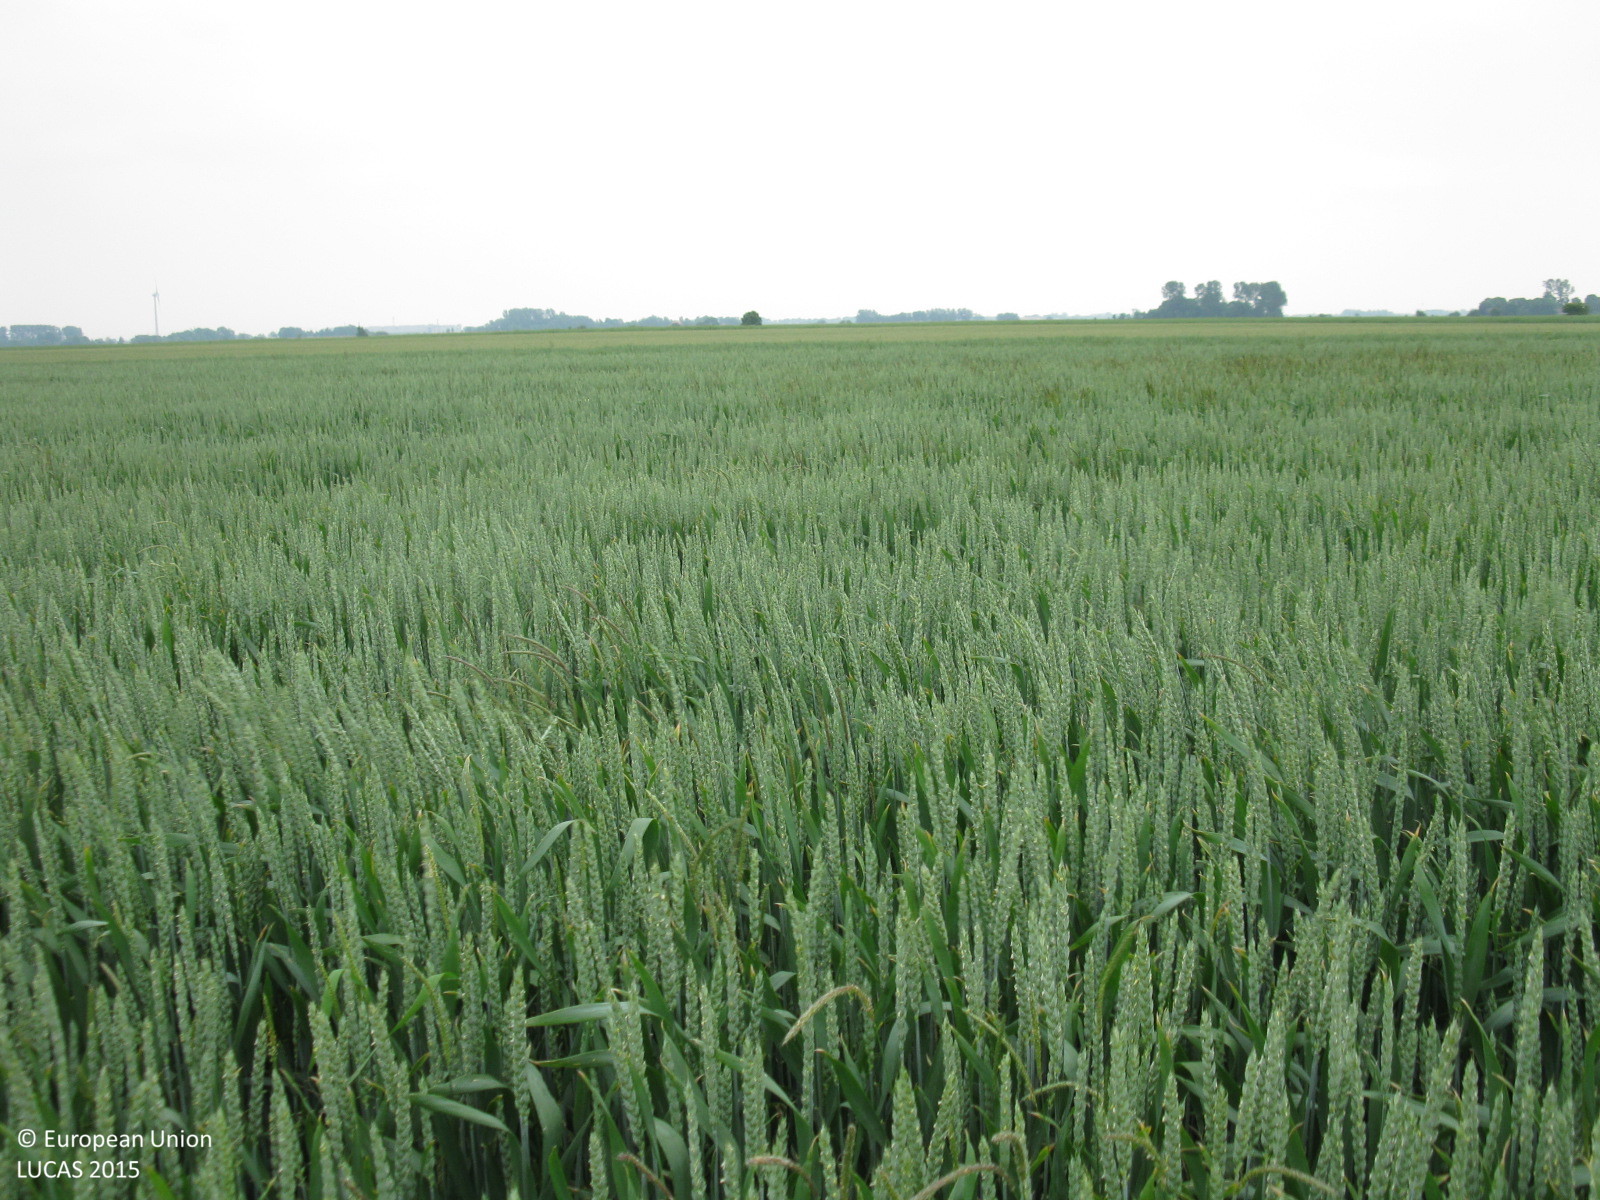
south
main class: Cropland
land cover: Common wheat
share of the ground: > 75 %
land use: Agriculture (excluding fallow land and kitchen gardens)
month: June
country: DE
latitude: 53.4971
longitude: 7.2722
